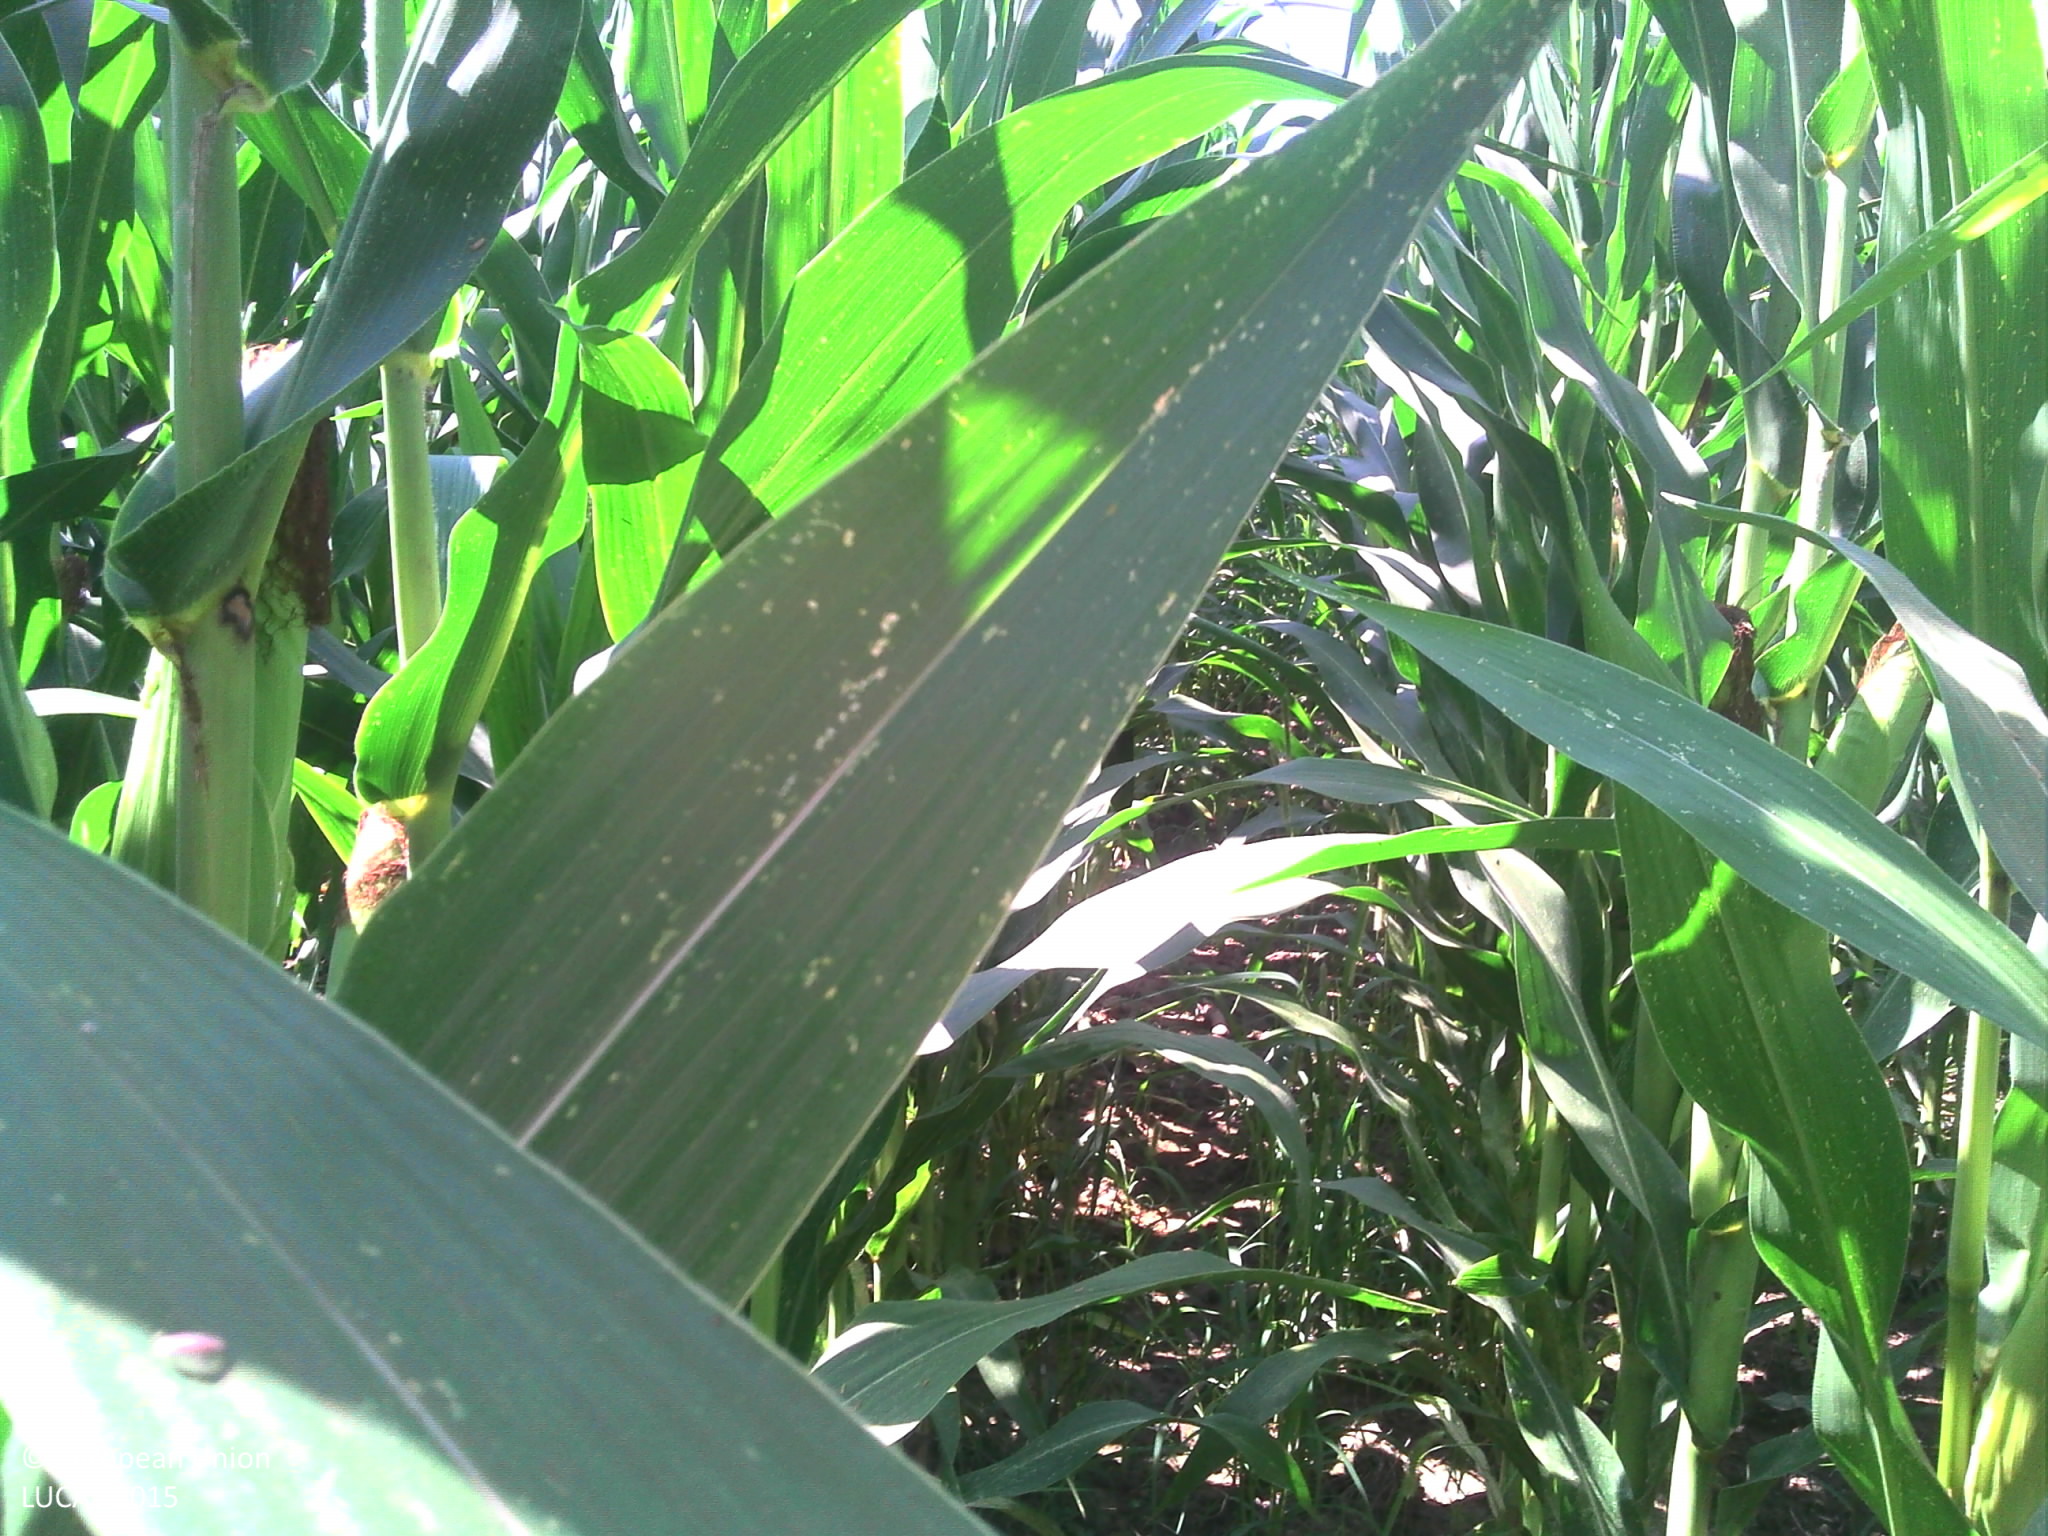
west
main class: Cropland
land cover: Maize
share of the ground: > 75 %
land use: Agriculture (excluding fallow land and kitchen gardens)
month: August
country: FR
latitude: 44.0350
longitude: 1.2521
